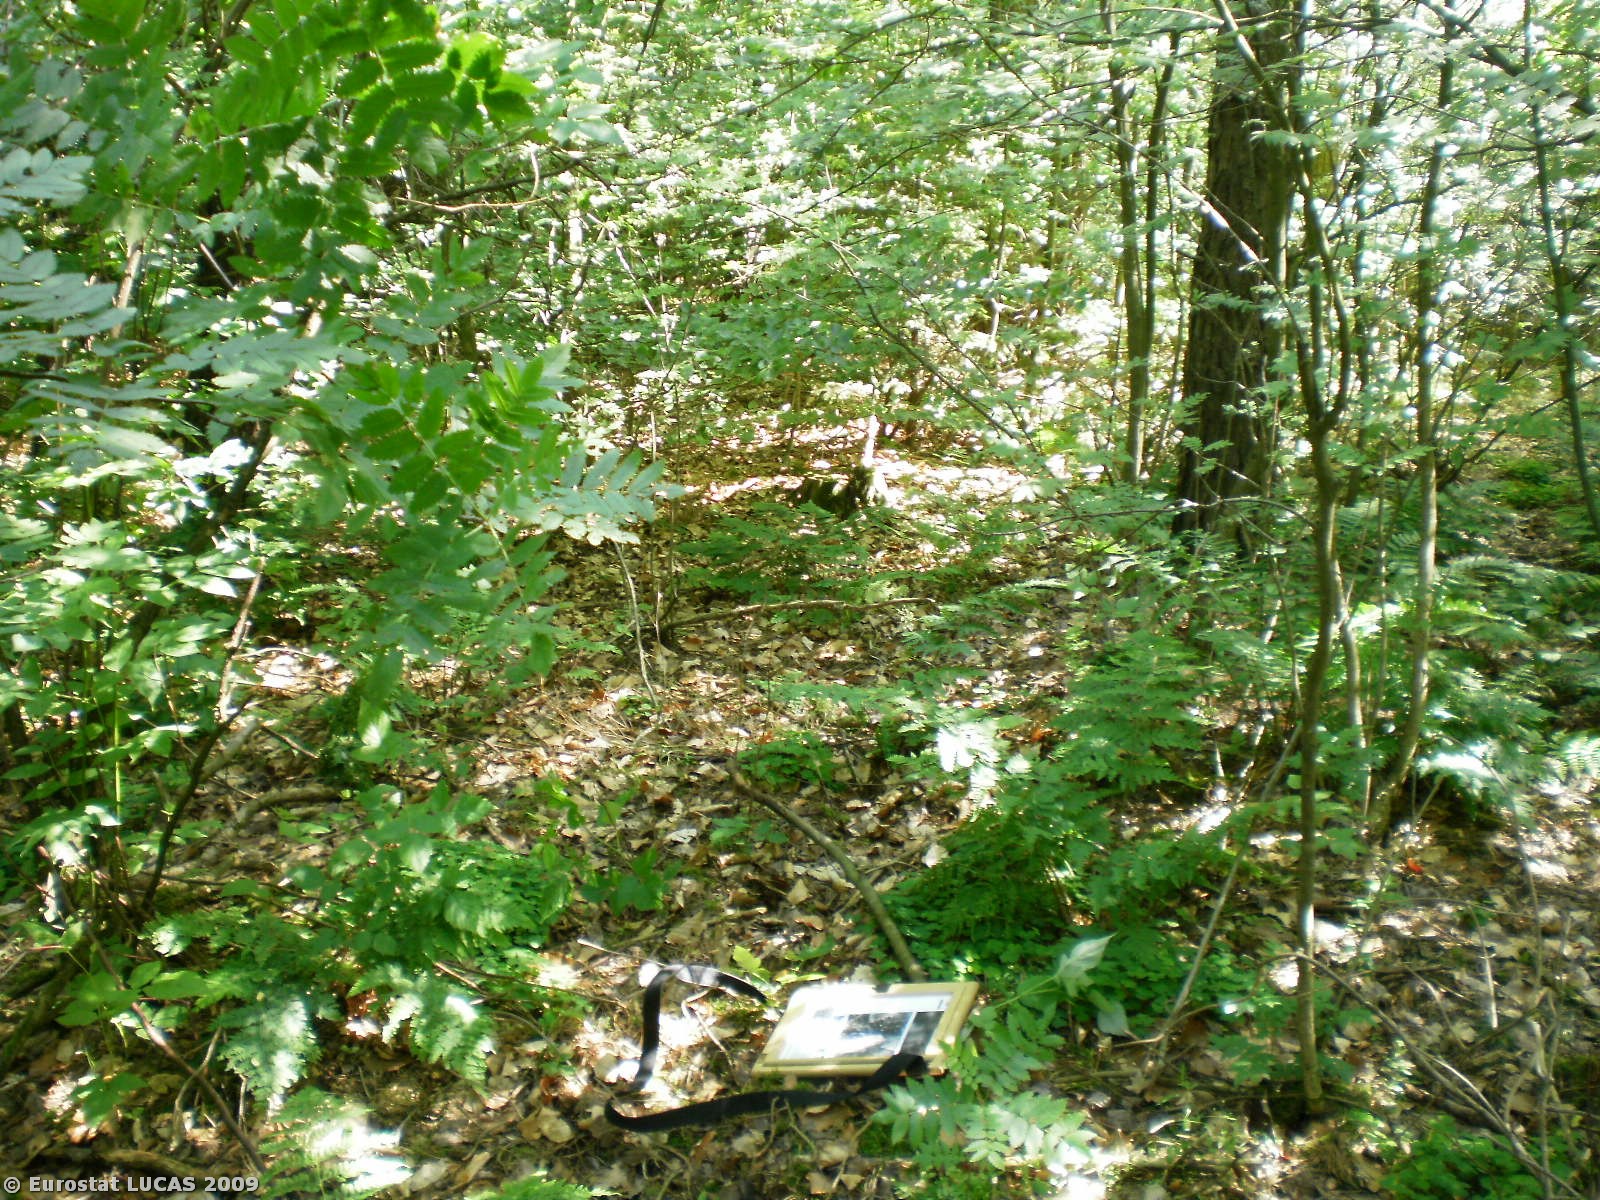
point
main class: Woodland
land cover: Mixed woodland
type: hemiboreal forest and nemoral coniferous forest and mixed broadleaved-coniferous forest
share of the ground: > 75 %
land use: Forestry
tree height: > 5 m
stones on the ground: < 10 %
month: June
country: PL
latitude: 54.5521
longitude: 17.3225
